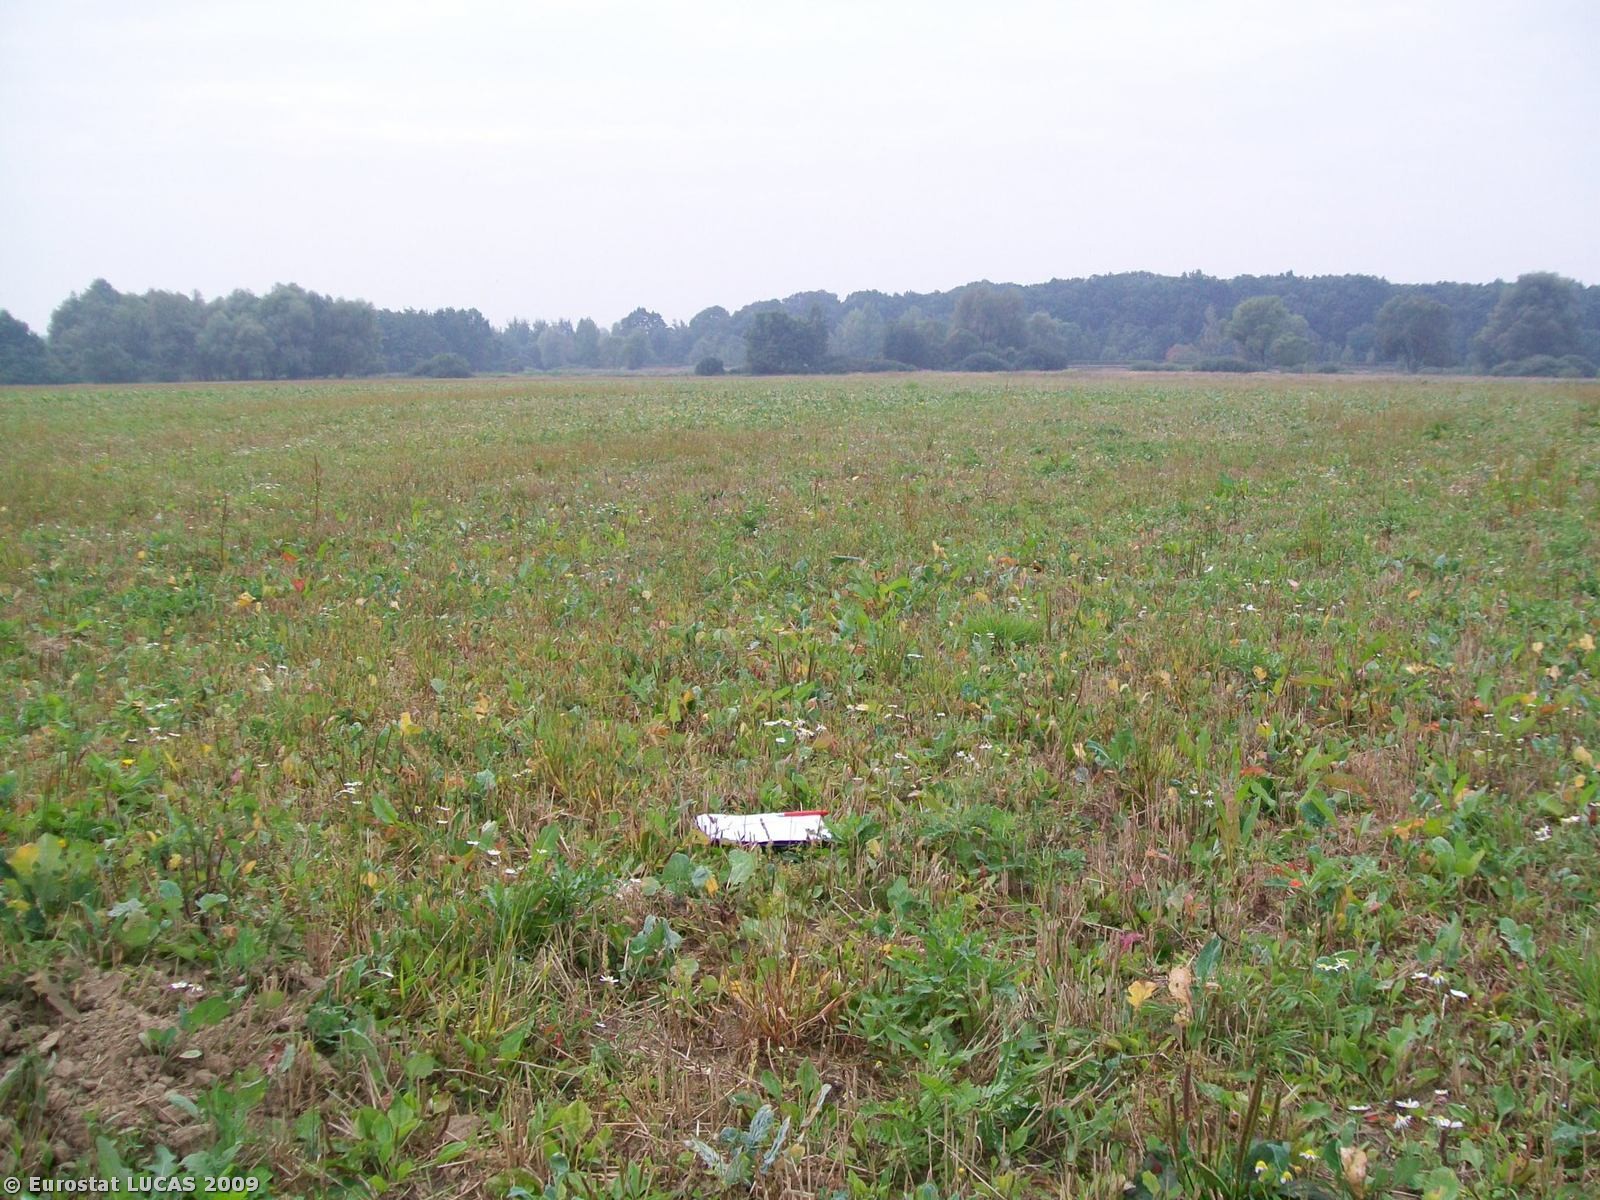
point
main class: Cropland
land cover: Barley
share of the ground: < 10 %
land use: Agriculture (excluding fallow land and kitchen gardens)
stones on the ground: < 10 %
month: September
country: PL
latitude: 50.4382
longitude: 17.2908
